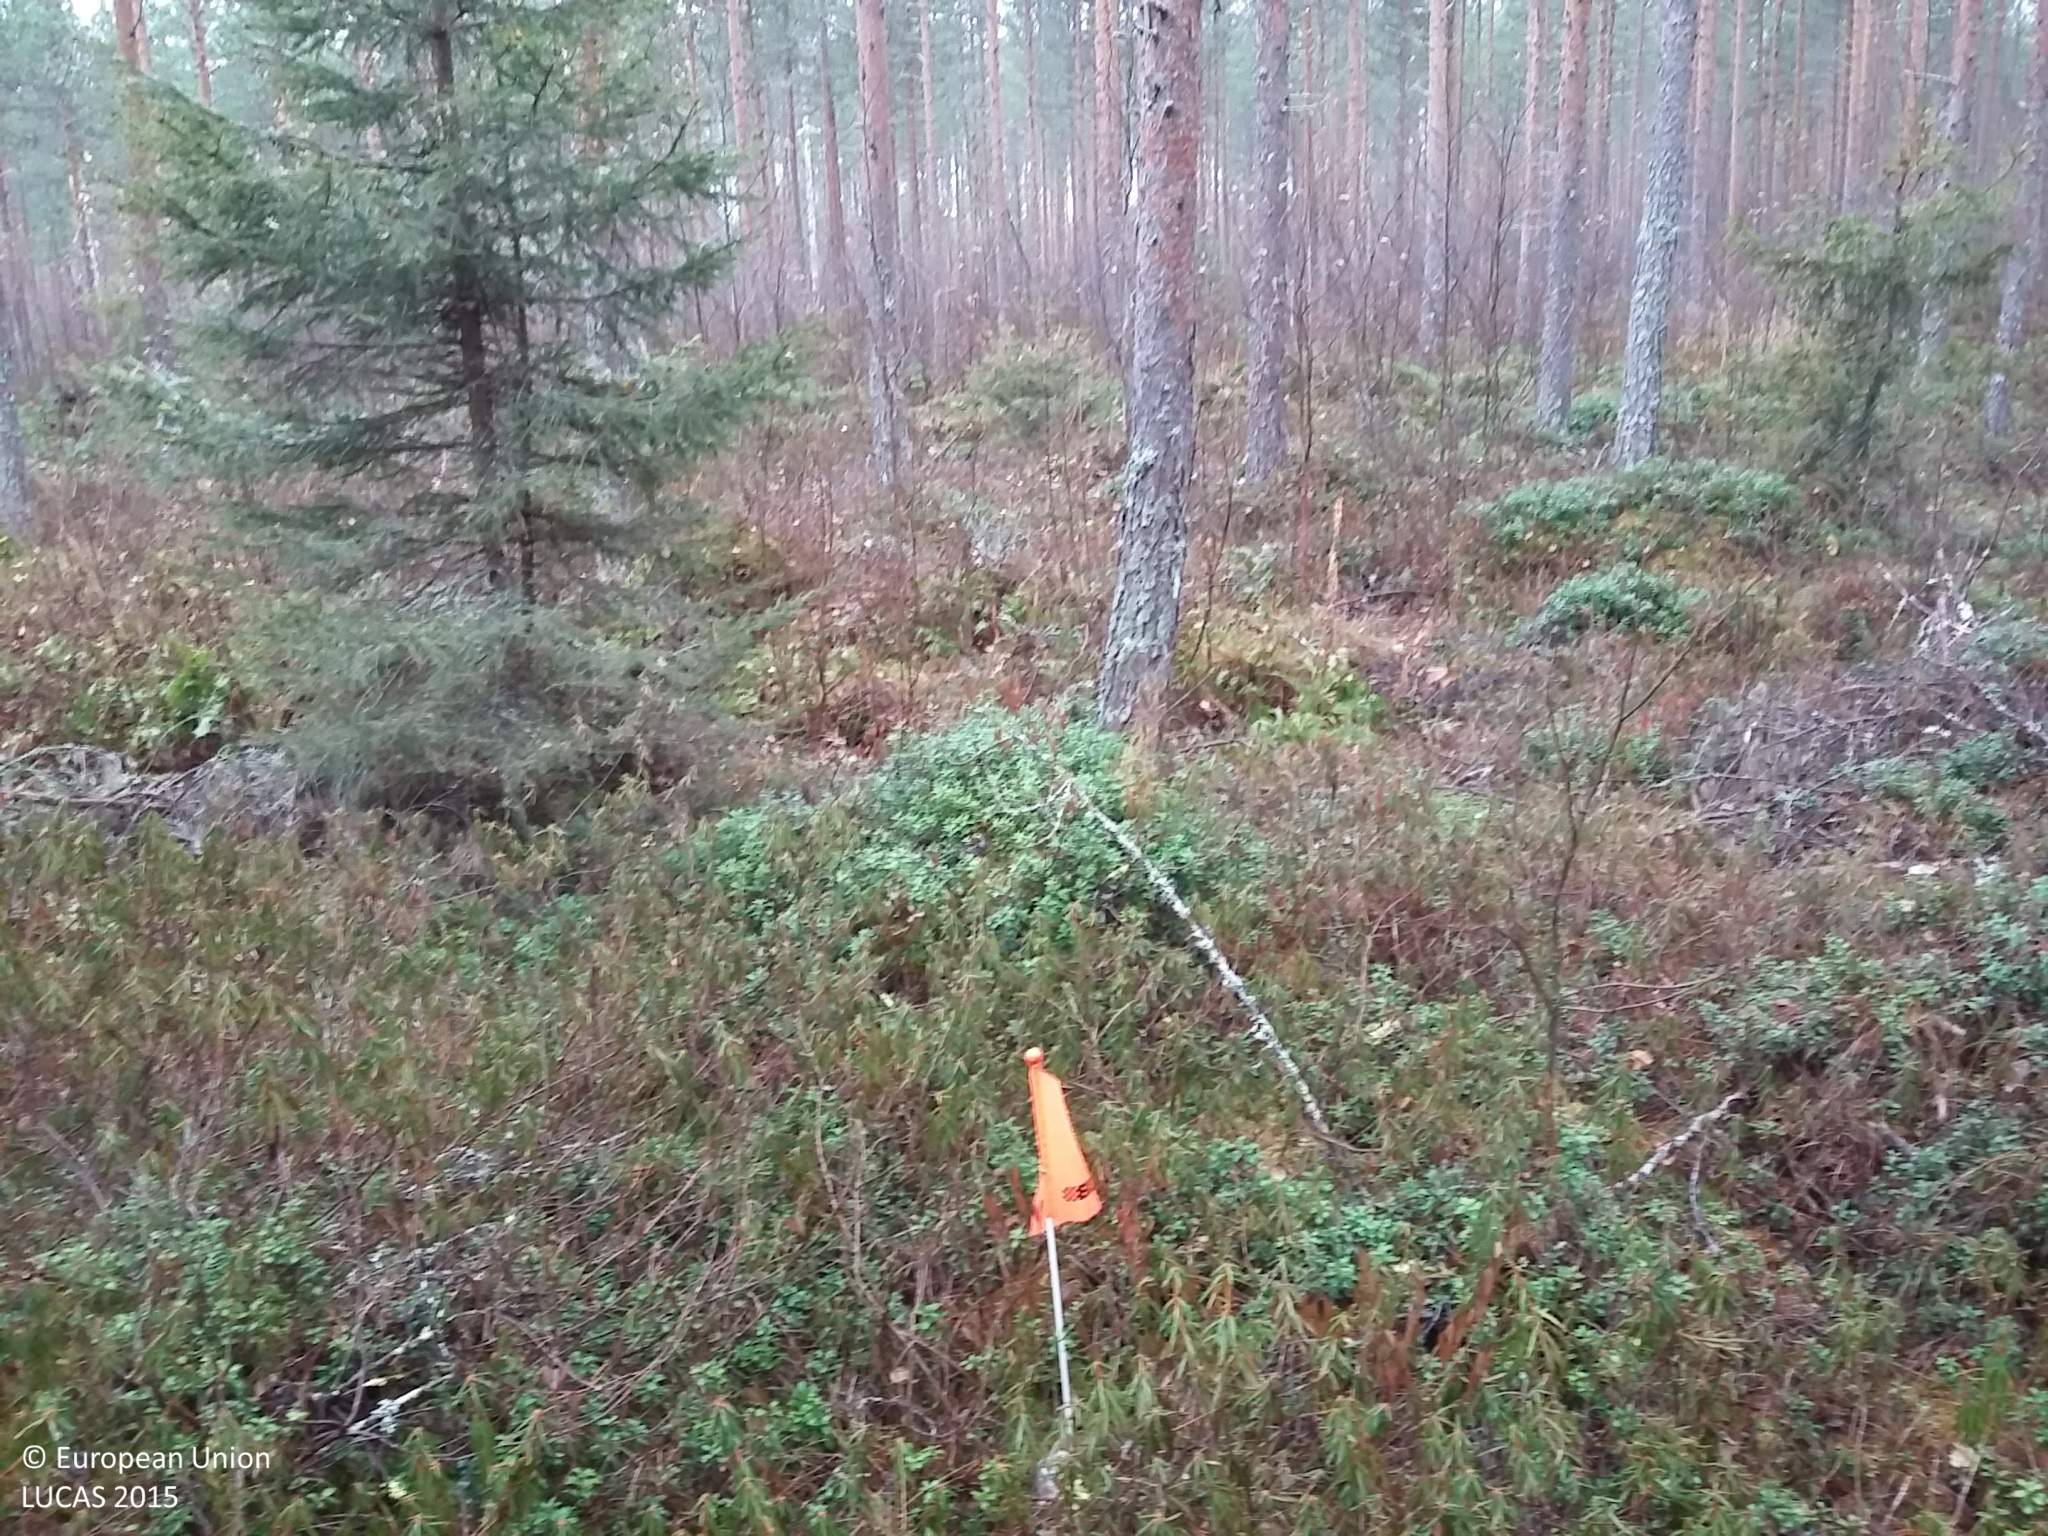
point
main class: Woodland
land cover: Pine dominated coniferous woodland
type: boreal forest
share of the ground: 50 - 75 %
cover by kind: coniferous forest trees 70 %, shrubs 20 %, lichens and mosses 10 %
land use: Forestry
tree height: > 5 m
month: October
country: FI
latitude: 64.3999
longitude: 25.3757
